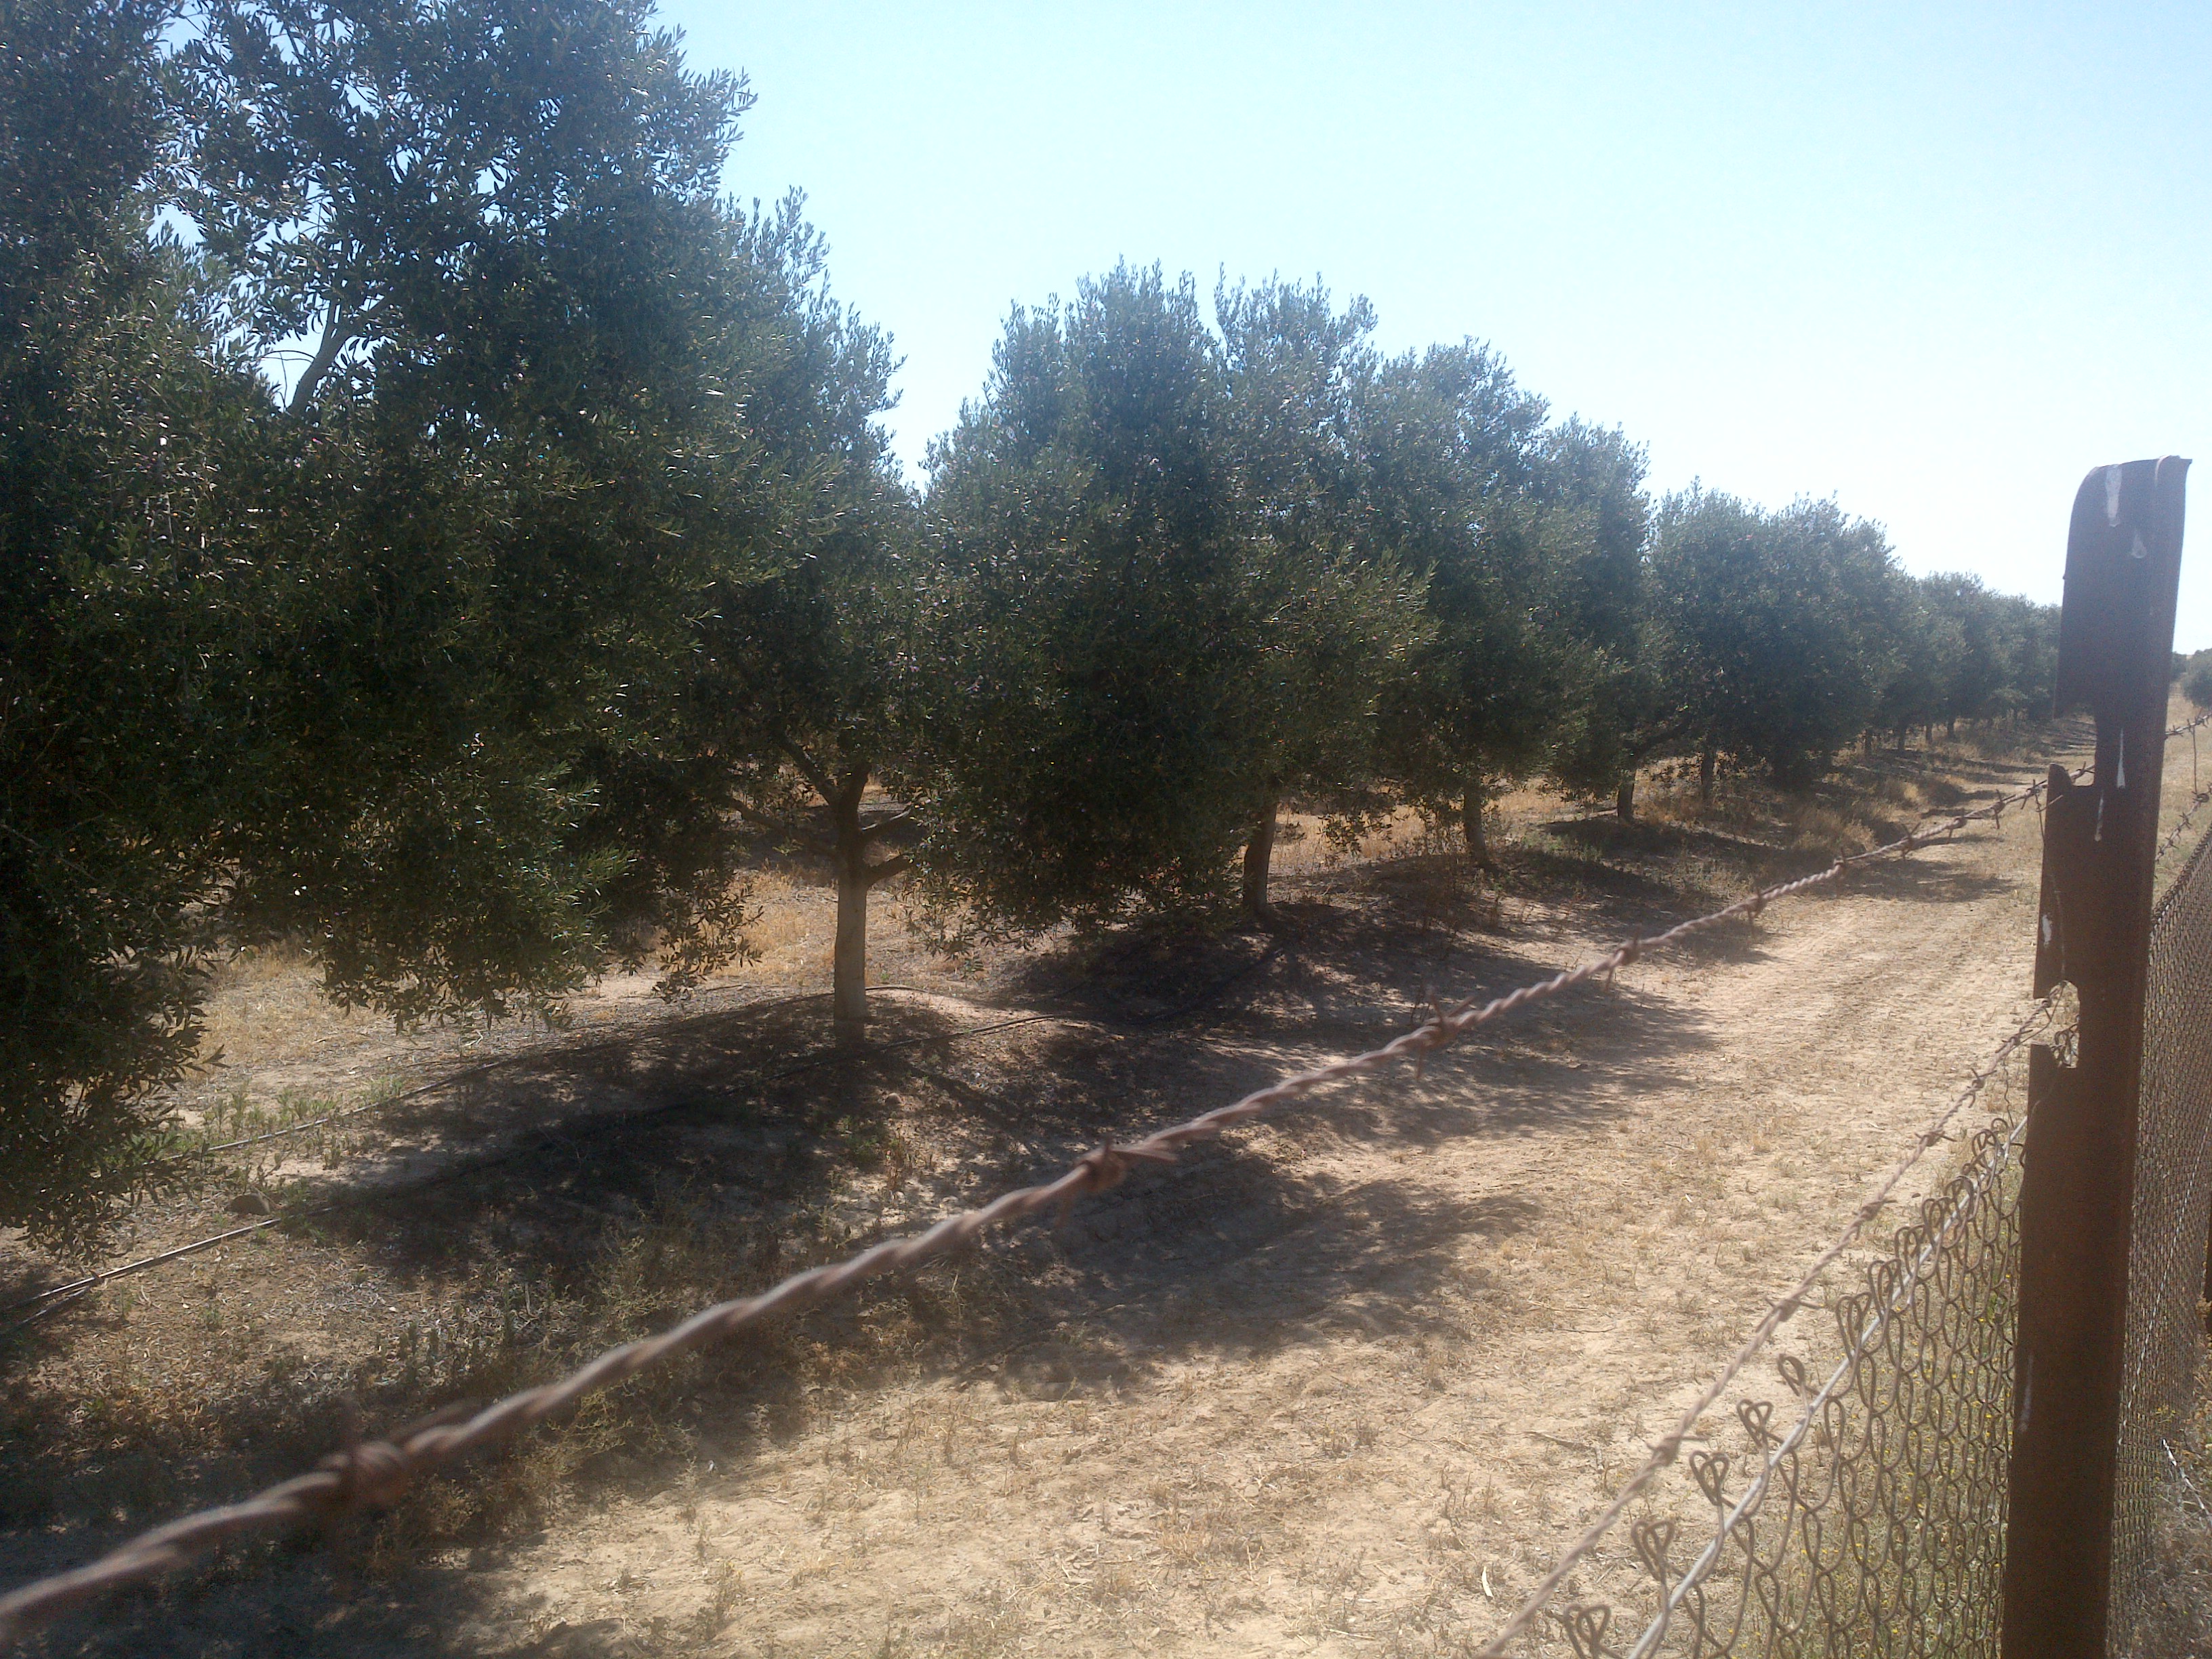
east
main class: Cropland
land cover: Olive groves
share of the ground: 50 - 75 %
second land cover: Spontaneously vegetated surfaces
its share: 10 - 25 %
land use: Agriculture (excluding fallow land and kitchen gardens)
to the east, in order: Olive groves; Spontaneously vegetated surfaces; Olive groves
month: June
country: ES
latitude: 37.7134
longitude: -5.2069
